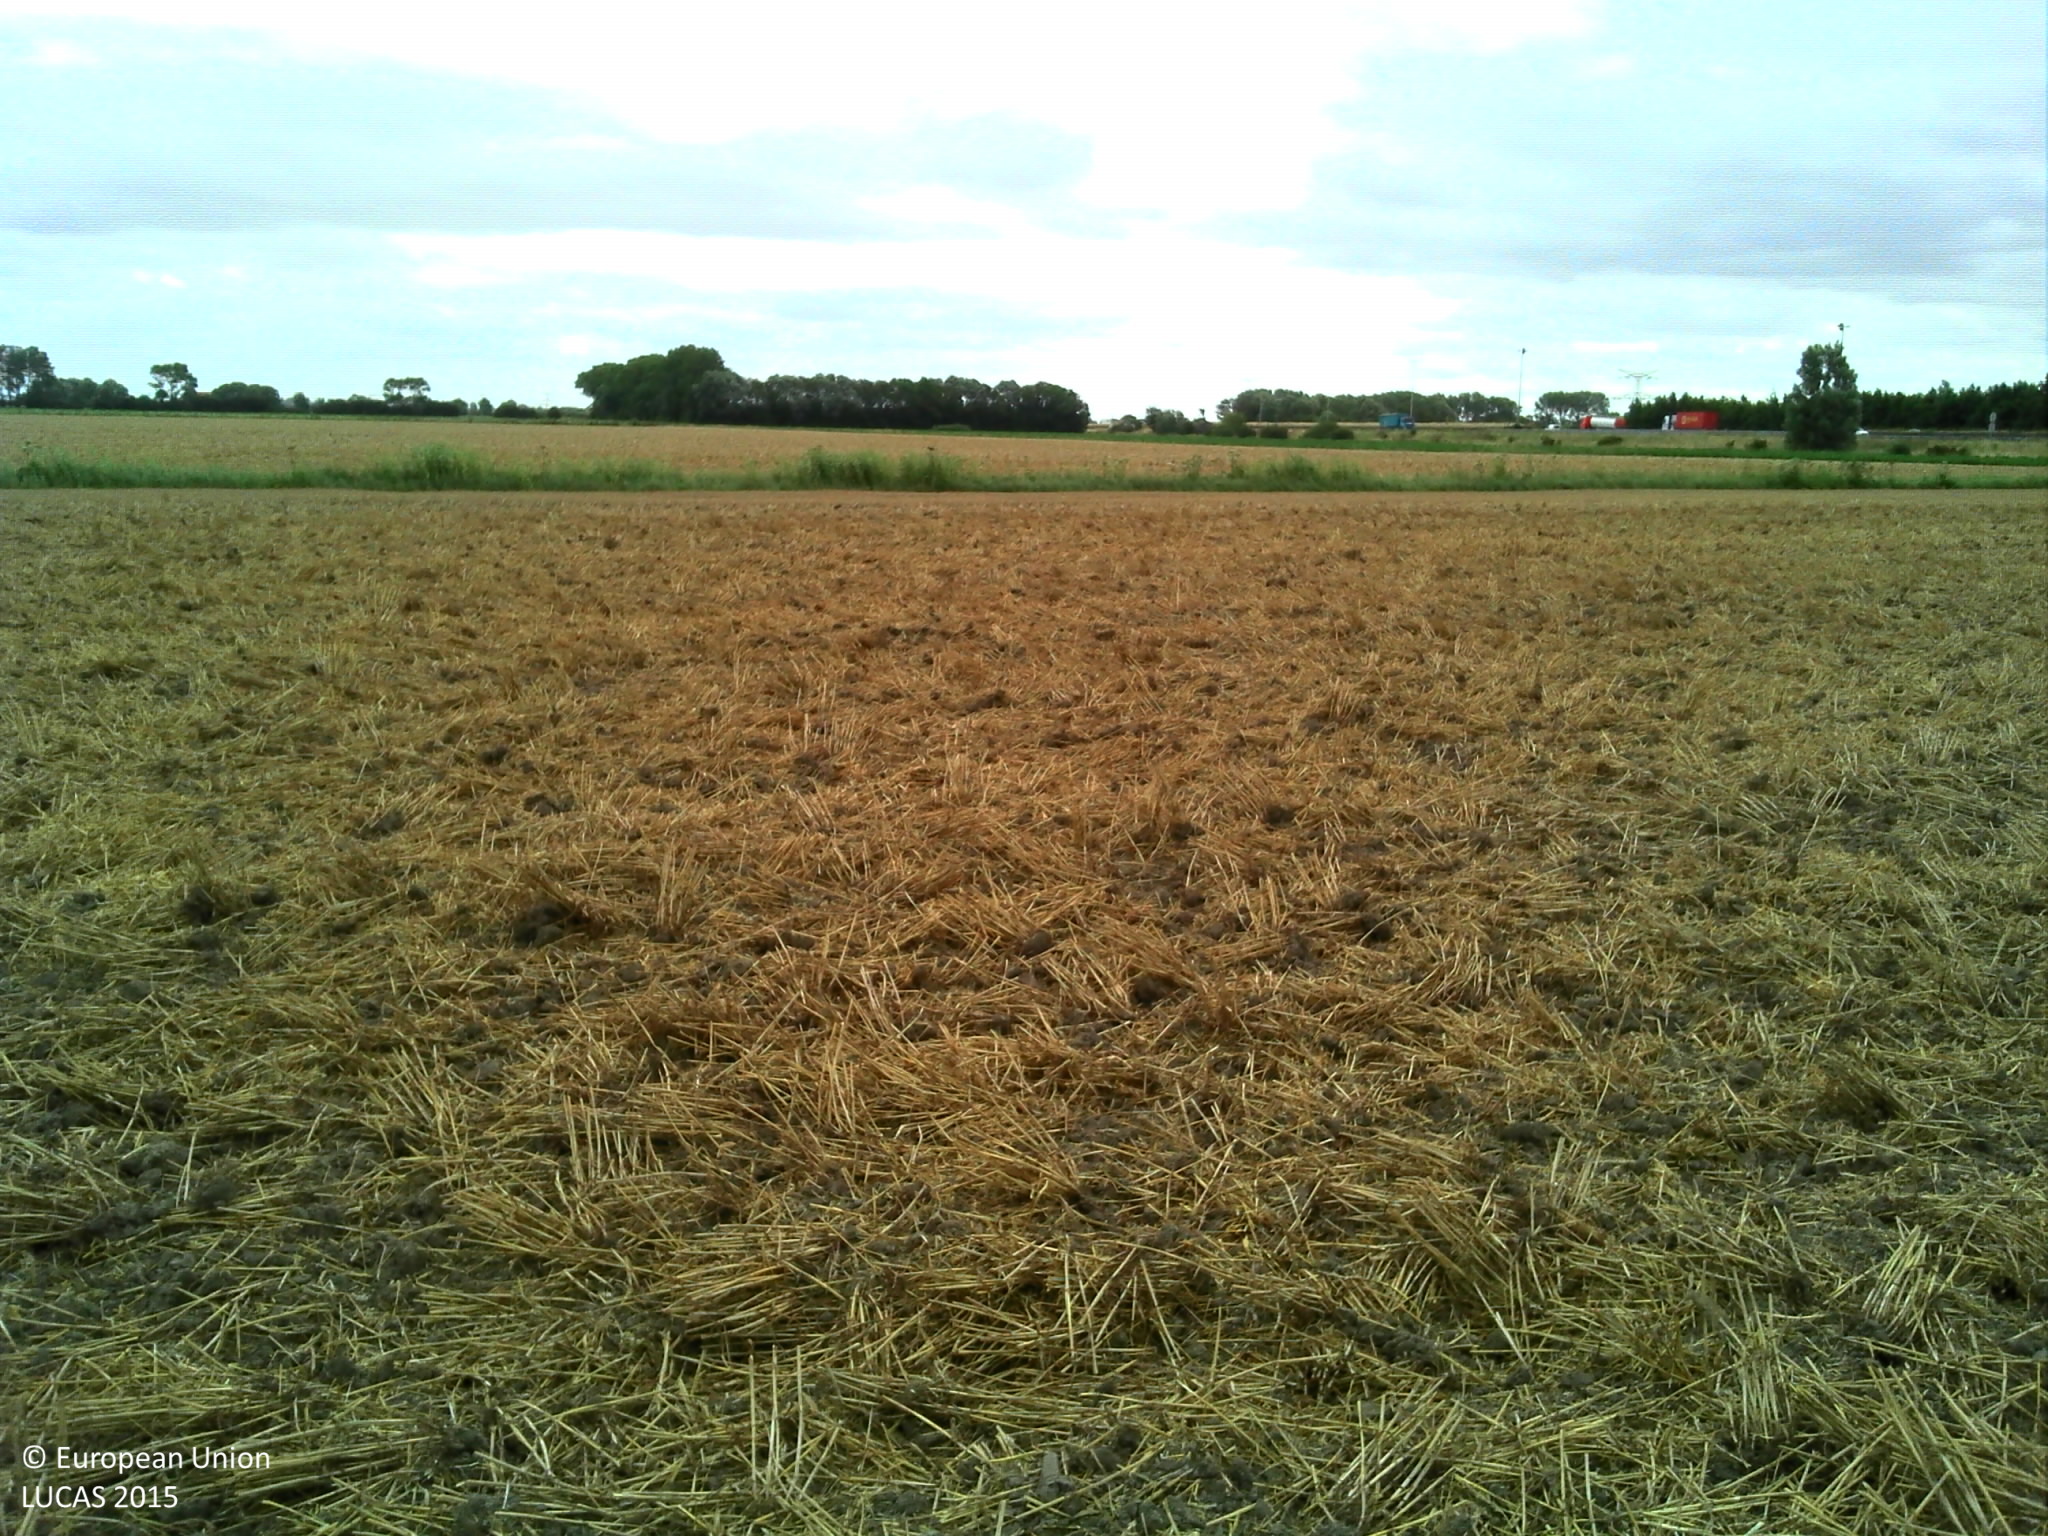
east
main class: Cropland
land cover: Common wheat
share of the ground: 25 - 50 %
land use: Agriculture (excluding fallow land and kitchen gardens)
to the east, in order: Common wheat; Grass margins; Ditches and canals; Grass margins; Common wheat; Grass margins; Sugar beet
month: August
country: FR
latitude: 50.9369
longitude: 2.0582
